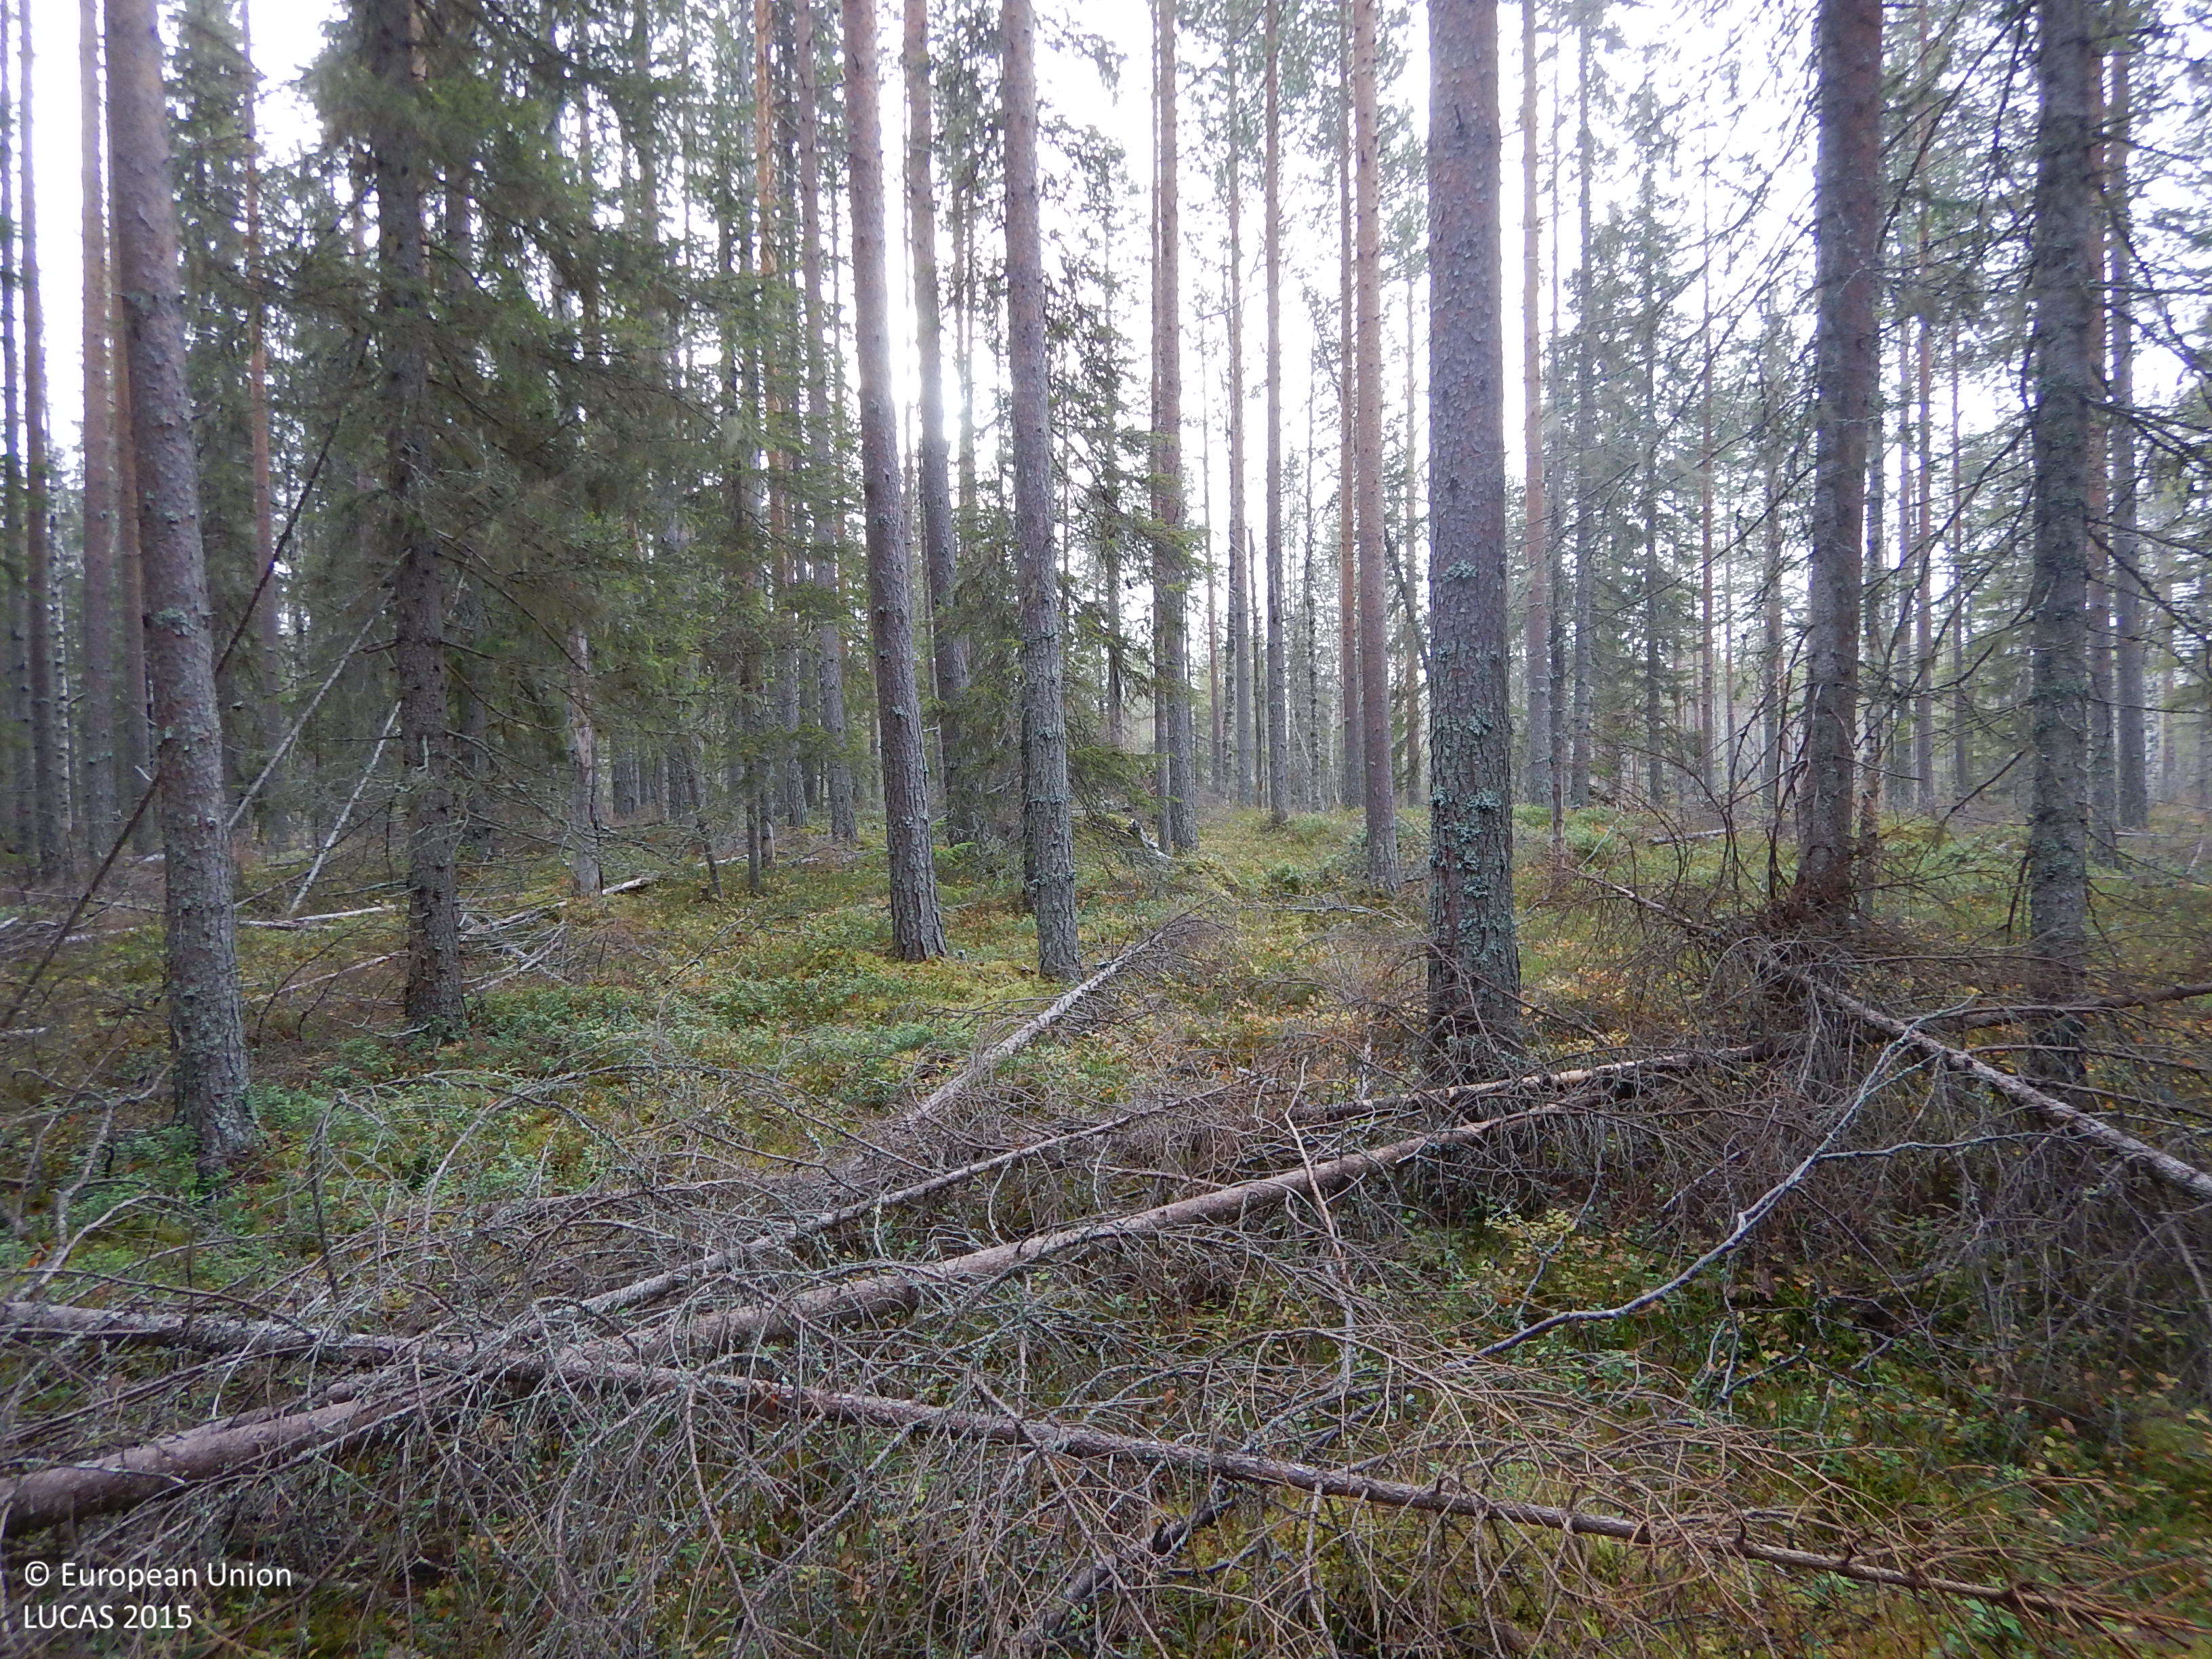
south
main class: Woodland
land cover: Other coniferous woodland
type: boreal forest
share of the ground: 50 - 75 %
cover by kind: coniferous forest trees 60 %, shrubs 15 %, lichens and mosses 15 %, broadleaved forest trees 5 %, herbaceous plants 5 %
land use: Forestry
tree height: > 5 m
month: October
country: SE
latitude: 65.1696
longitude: 20.1057
